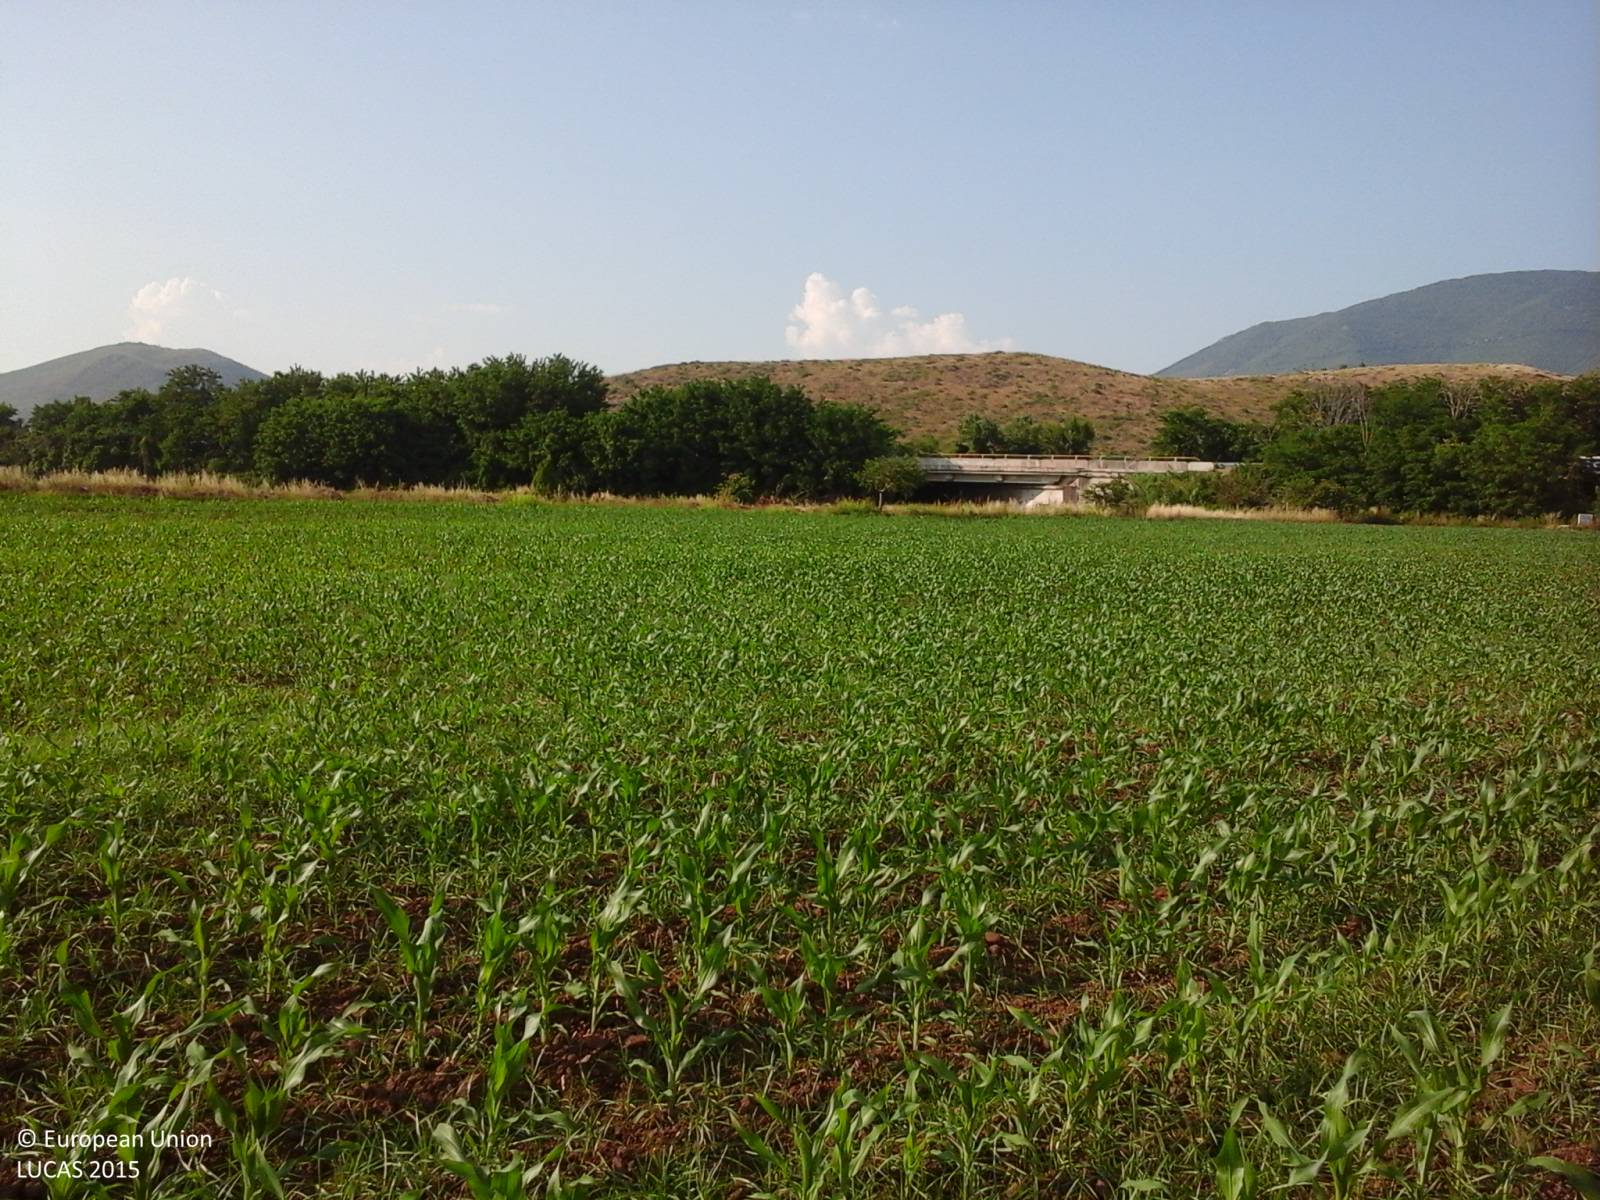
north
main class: Cropland
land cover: Maize
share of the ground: 25 - 50 %
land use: Agriculture (excluding fallow land and kitchen gardens)
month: June
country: IT
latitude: 41.1941
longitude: 14.1450
